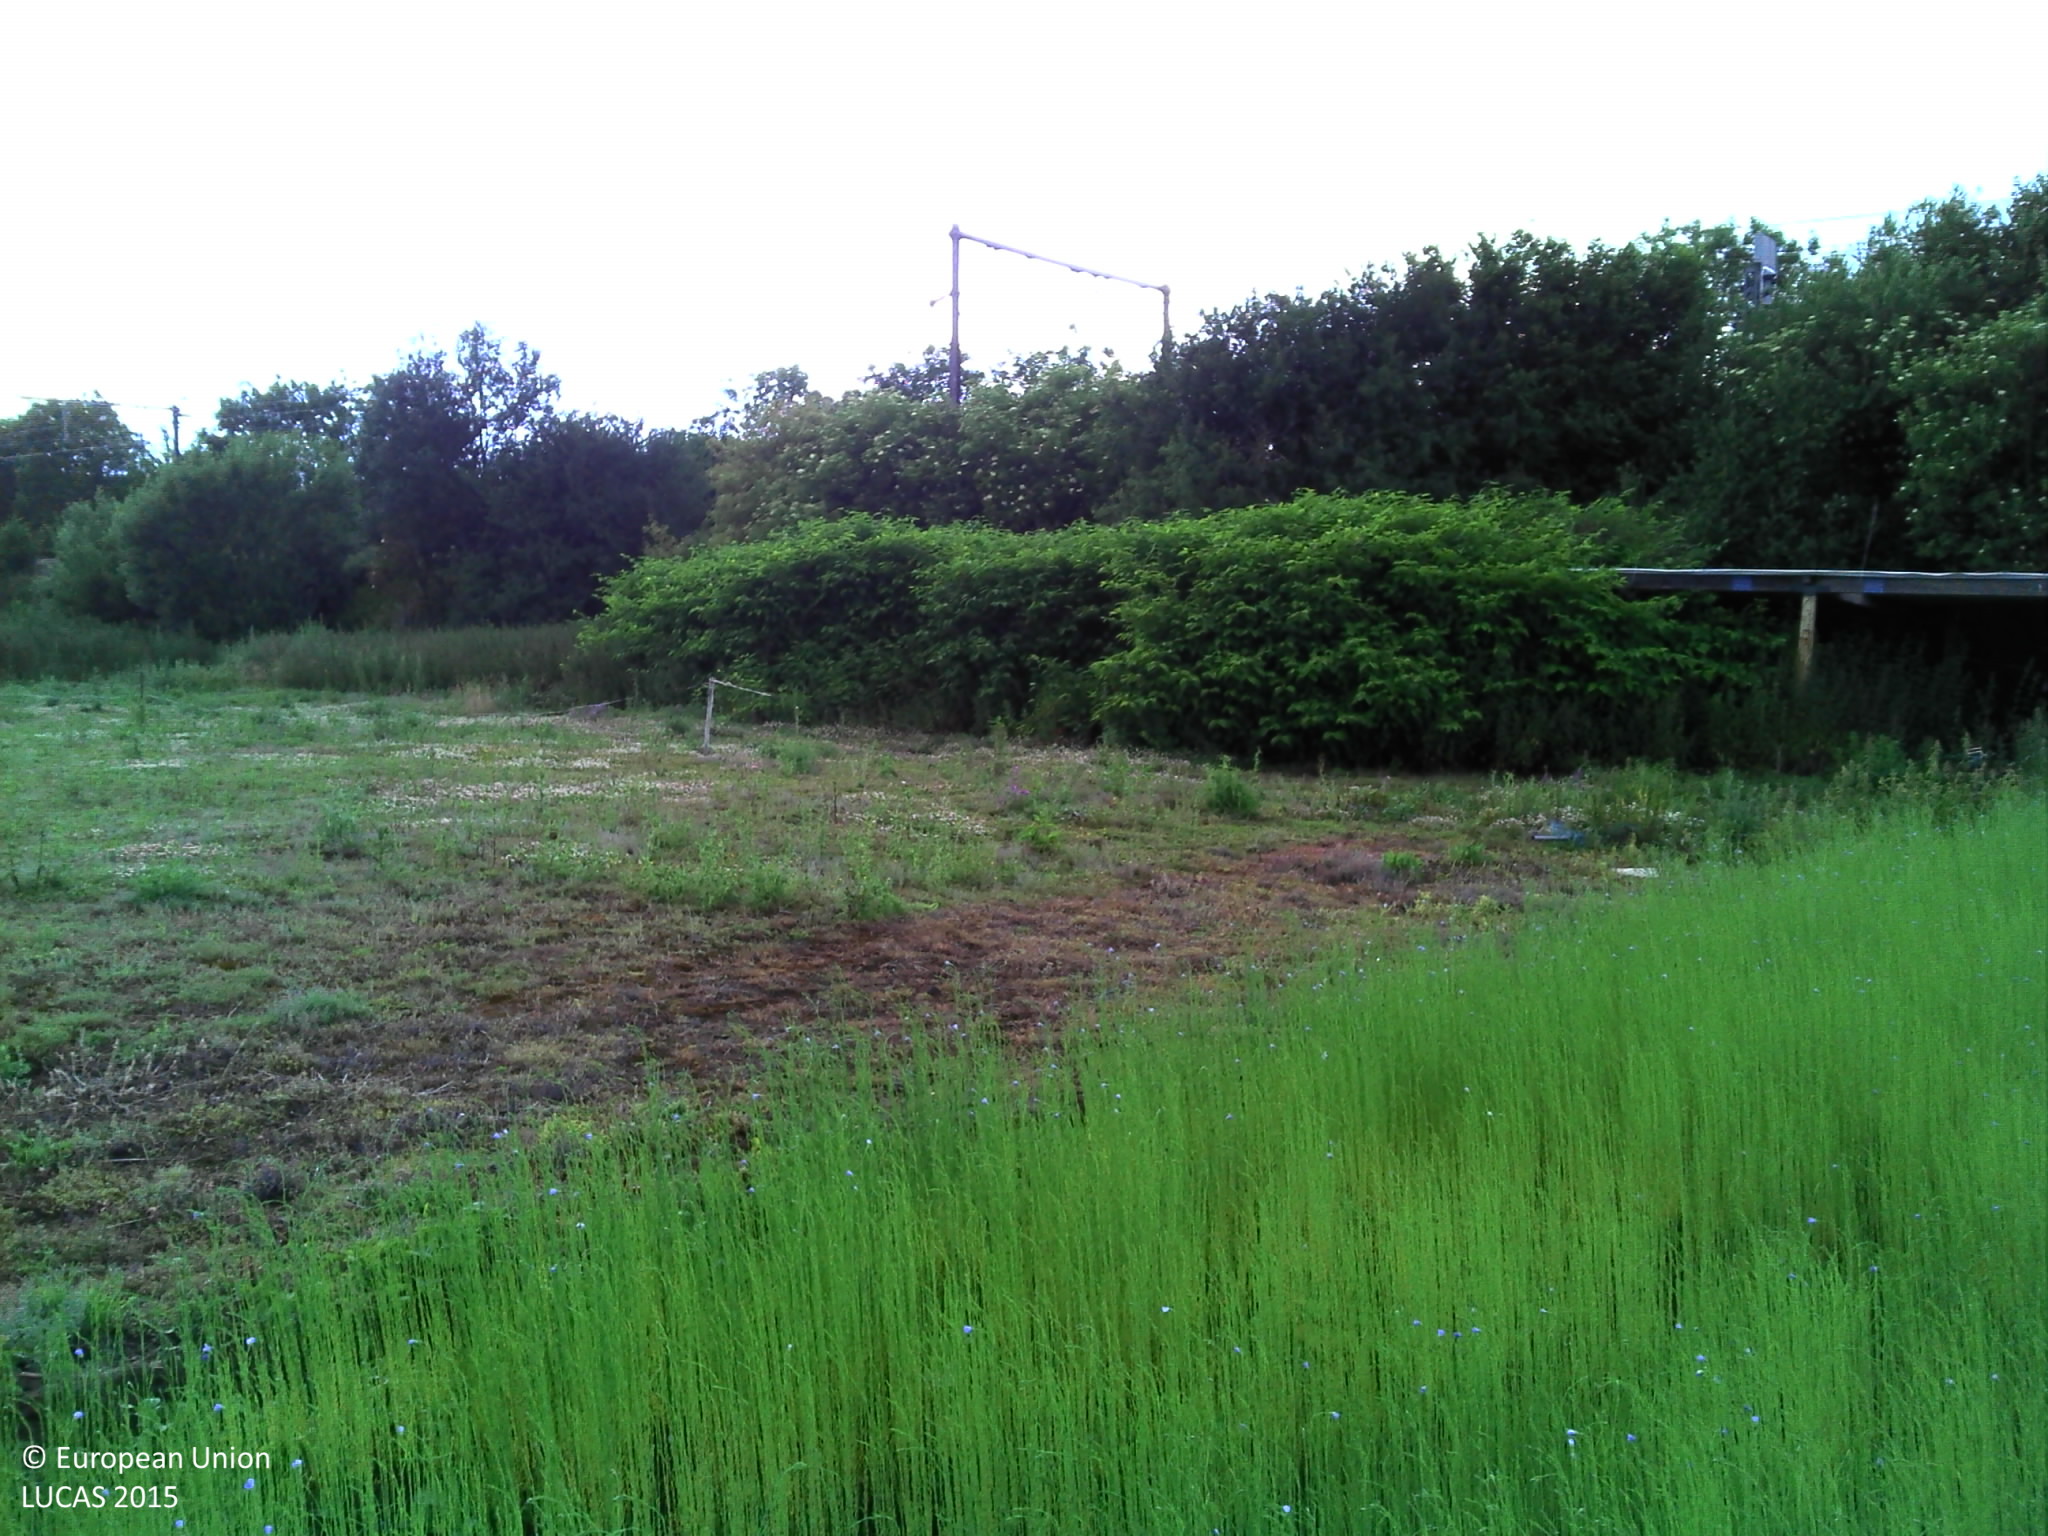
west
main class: Cropland
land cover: Other fibre and oleaginous crops
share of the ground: > 75 %
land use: Agriculture (excluding fallow land and kitchen gardens)
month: June
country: BE
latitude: 50.5504
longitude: 4.0243
